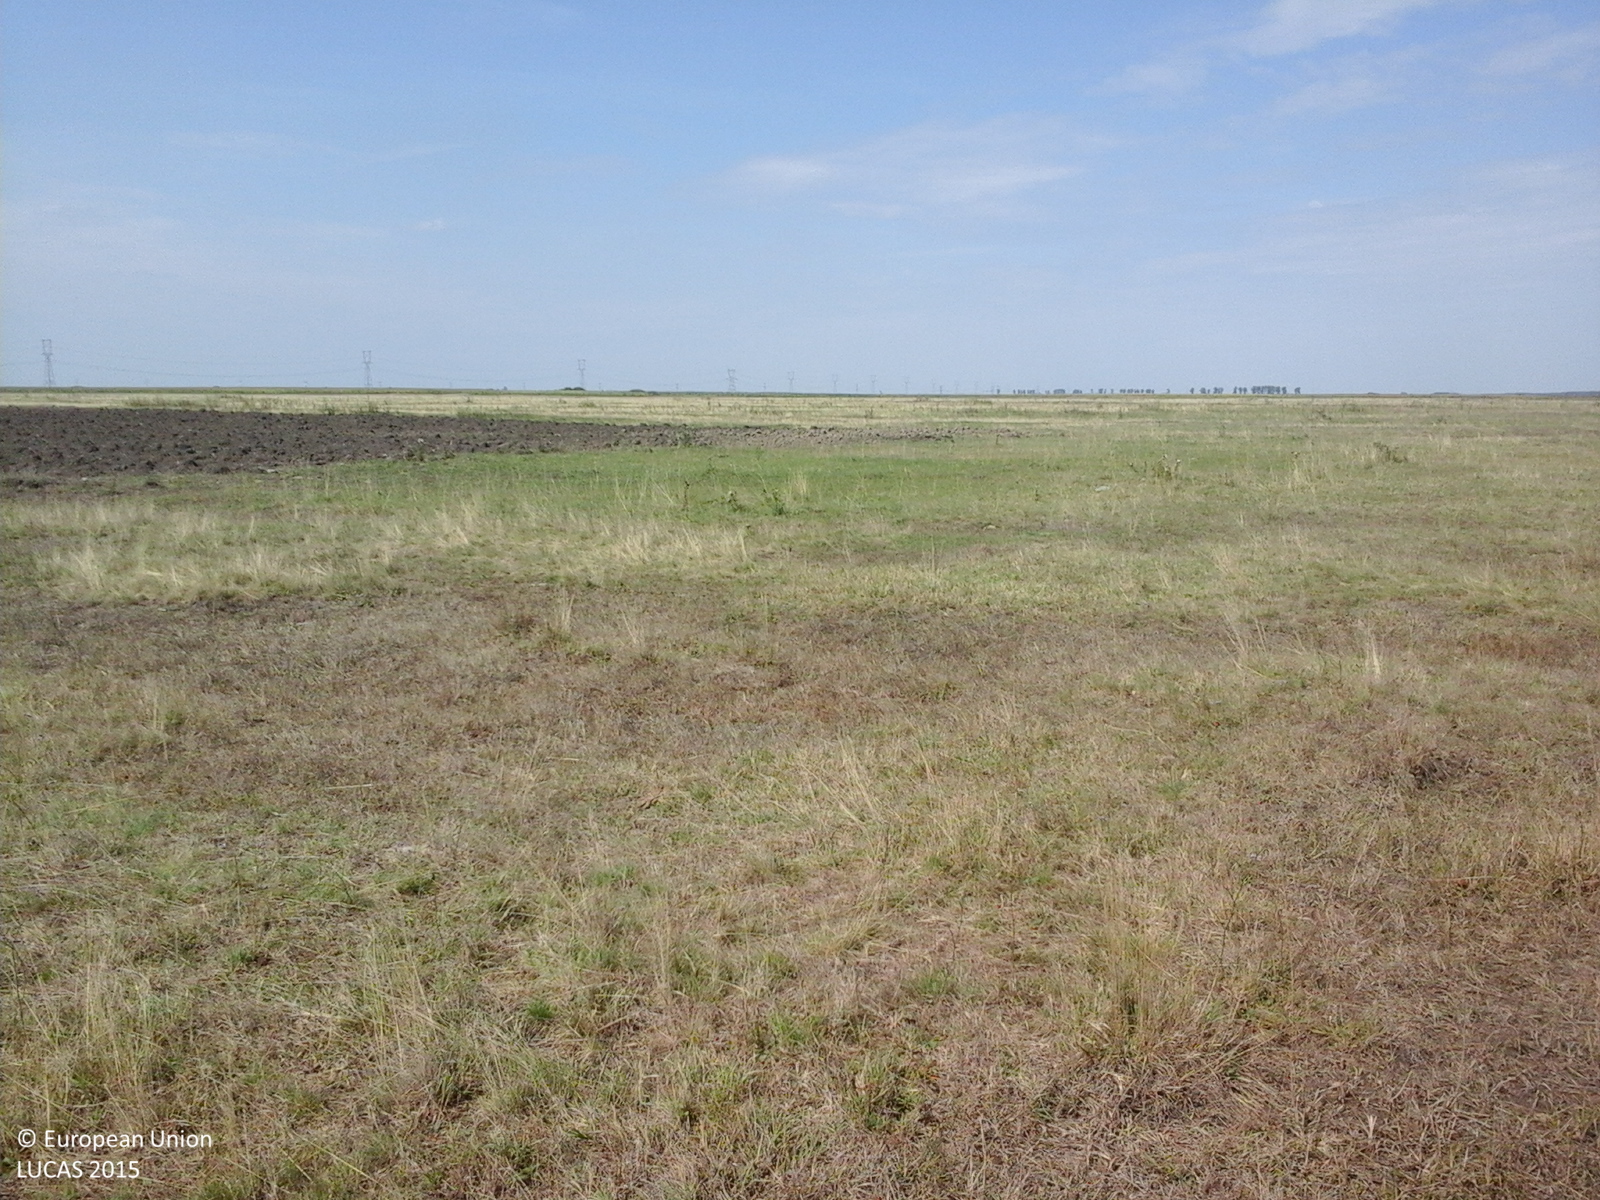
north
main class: Grassland
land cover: Grassland without tree/shrub cover
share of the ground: > 75 %
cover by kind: herbaceous plants 100 %
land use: Agriculture (excluding fallow land and kitchen gardens)
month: August
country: RO
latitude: 46.4169
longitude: 21.5259
